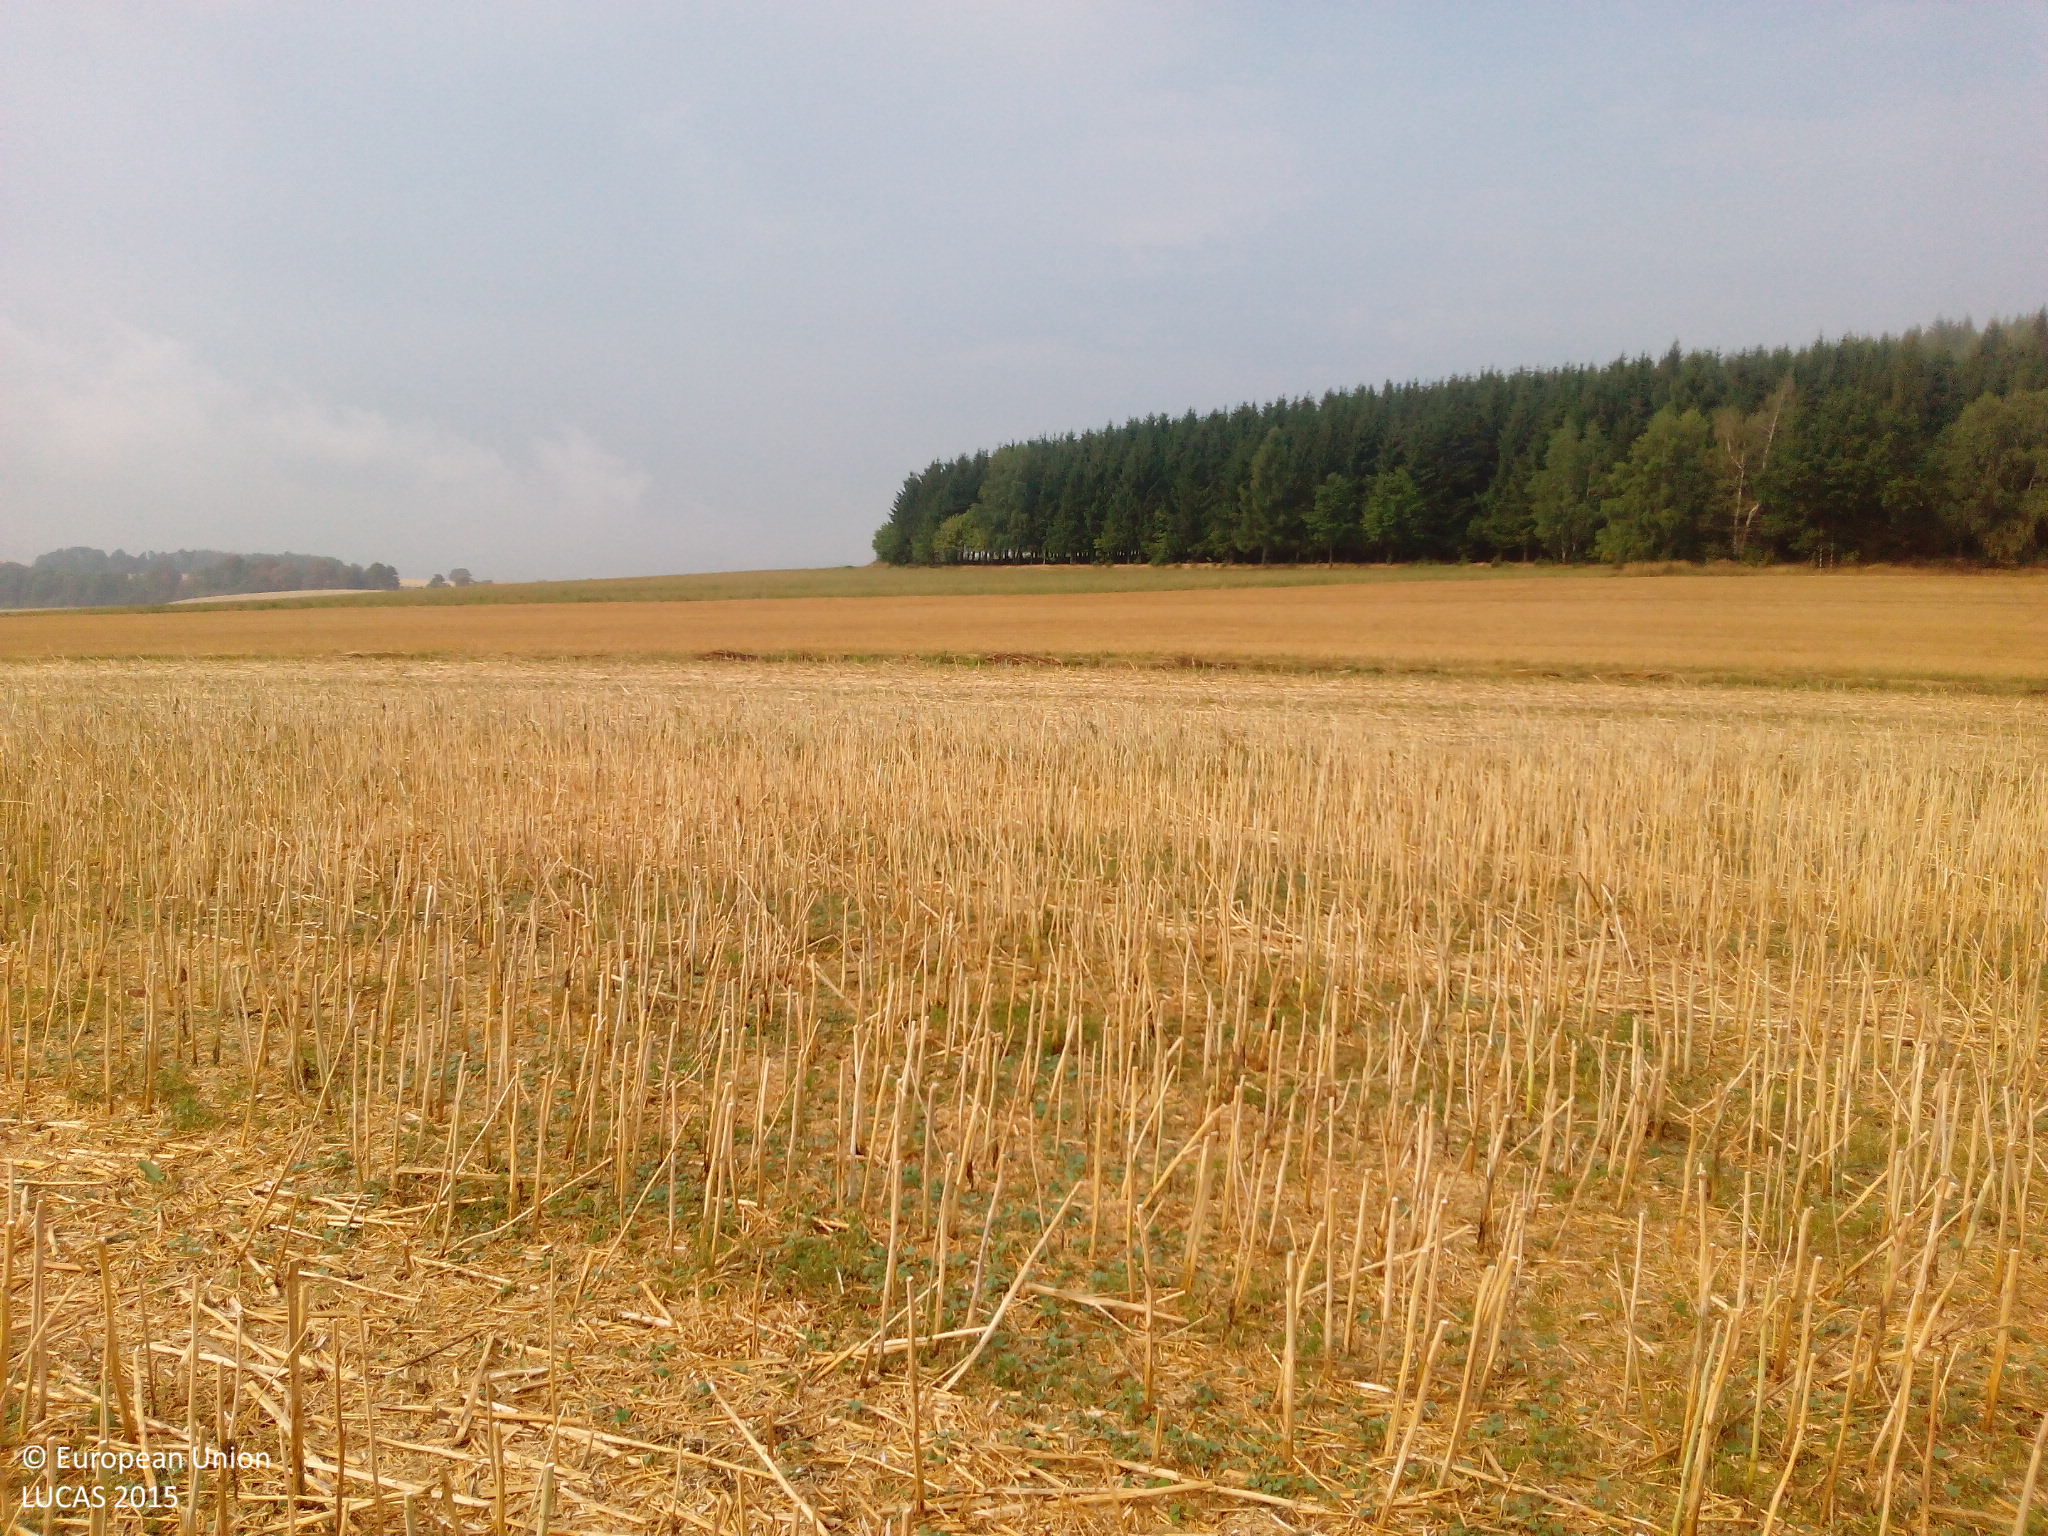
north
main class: Cropland
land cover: Rape and turnip rape
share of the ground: > 75 %
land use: Agriculture (excluding fallow land and kitchen gardens)
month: August
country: DE
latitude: 50.8143
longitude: 13.5061
